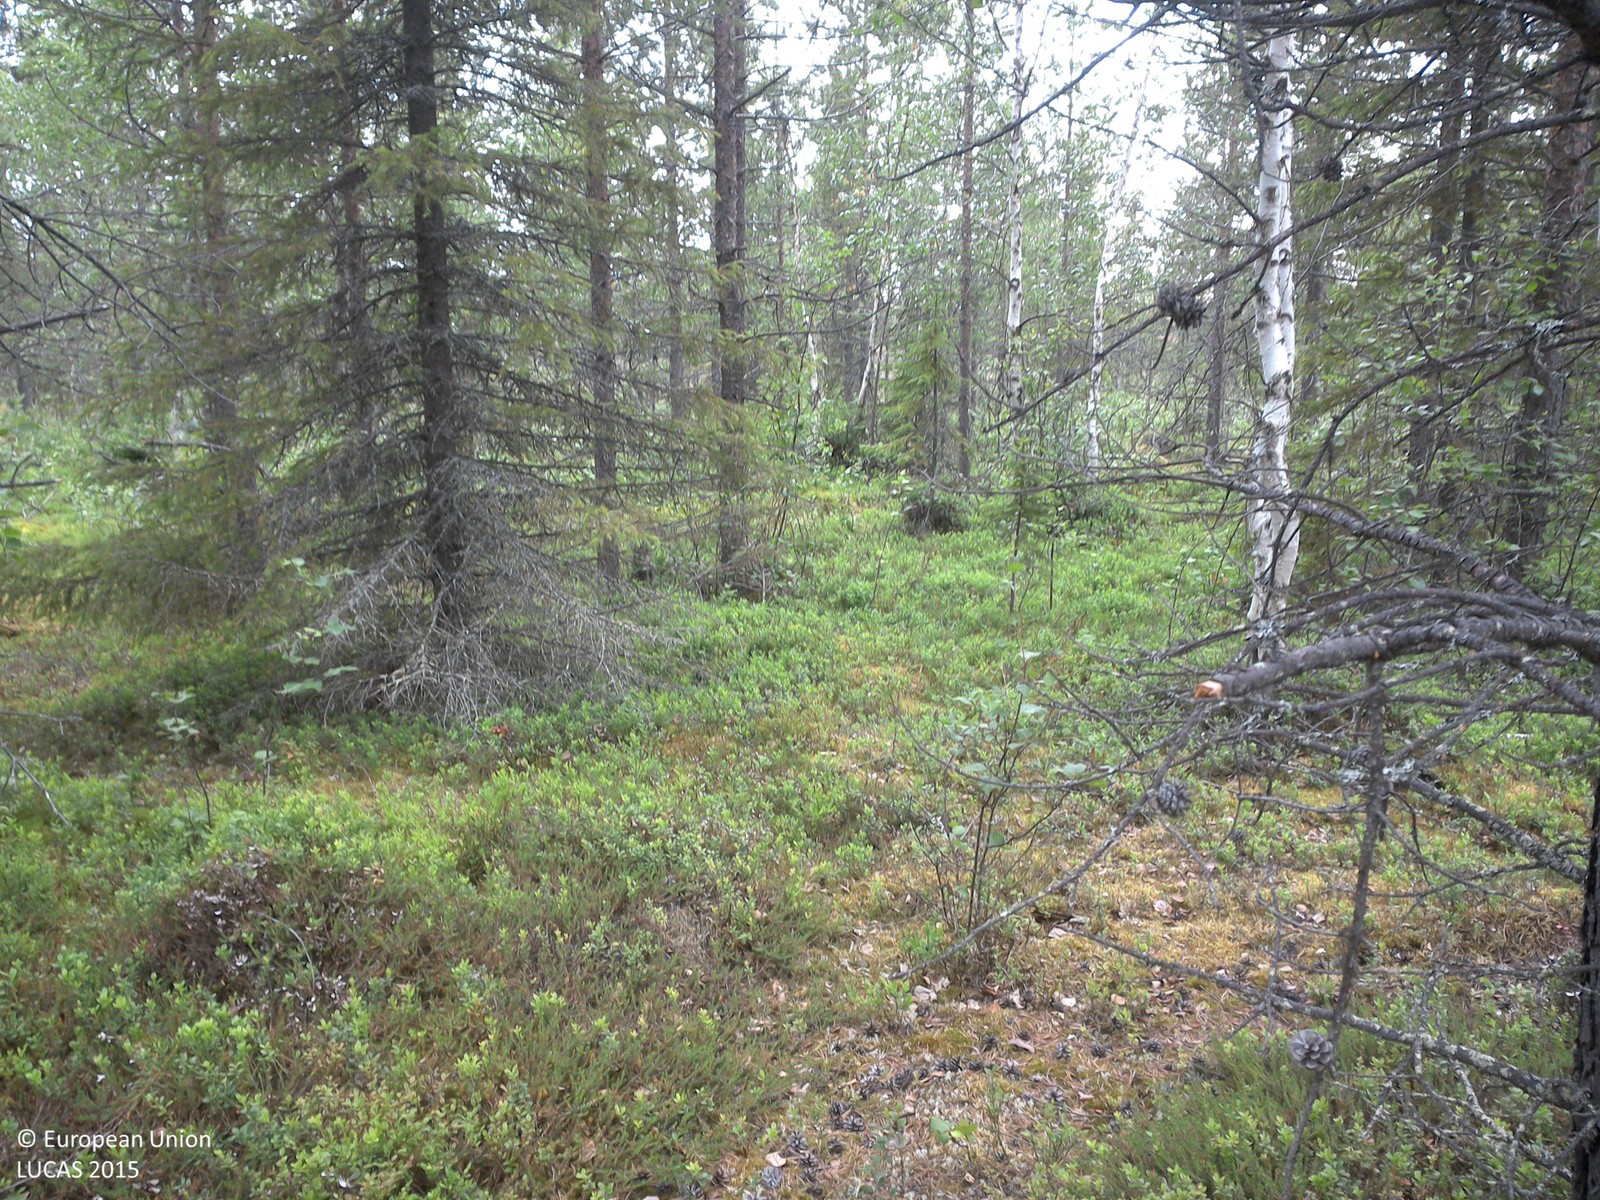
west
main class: Woodland
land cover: Pine dominated mixed woodland
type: boreal forest
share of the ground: 25 - 50 %
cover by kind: shrubs 45 %, coniferous forest trees 30 %, broadleaved forest trees 15 %, lichens and mosses 10 %
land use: Forestry
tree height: > 5 m
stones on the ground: 10 - 25 %
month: July
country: SE
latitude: 67.5216
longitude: 22.7334
